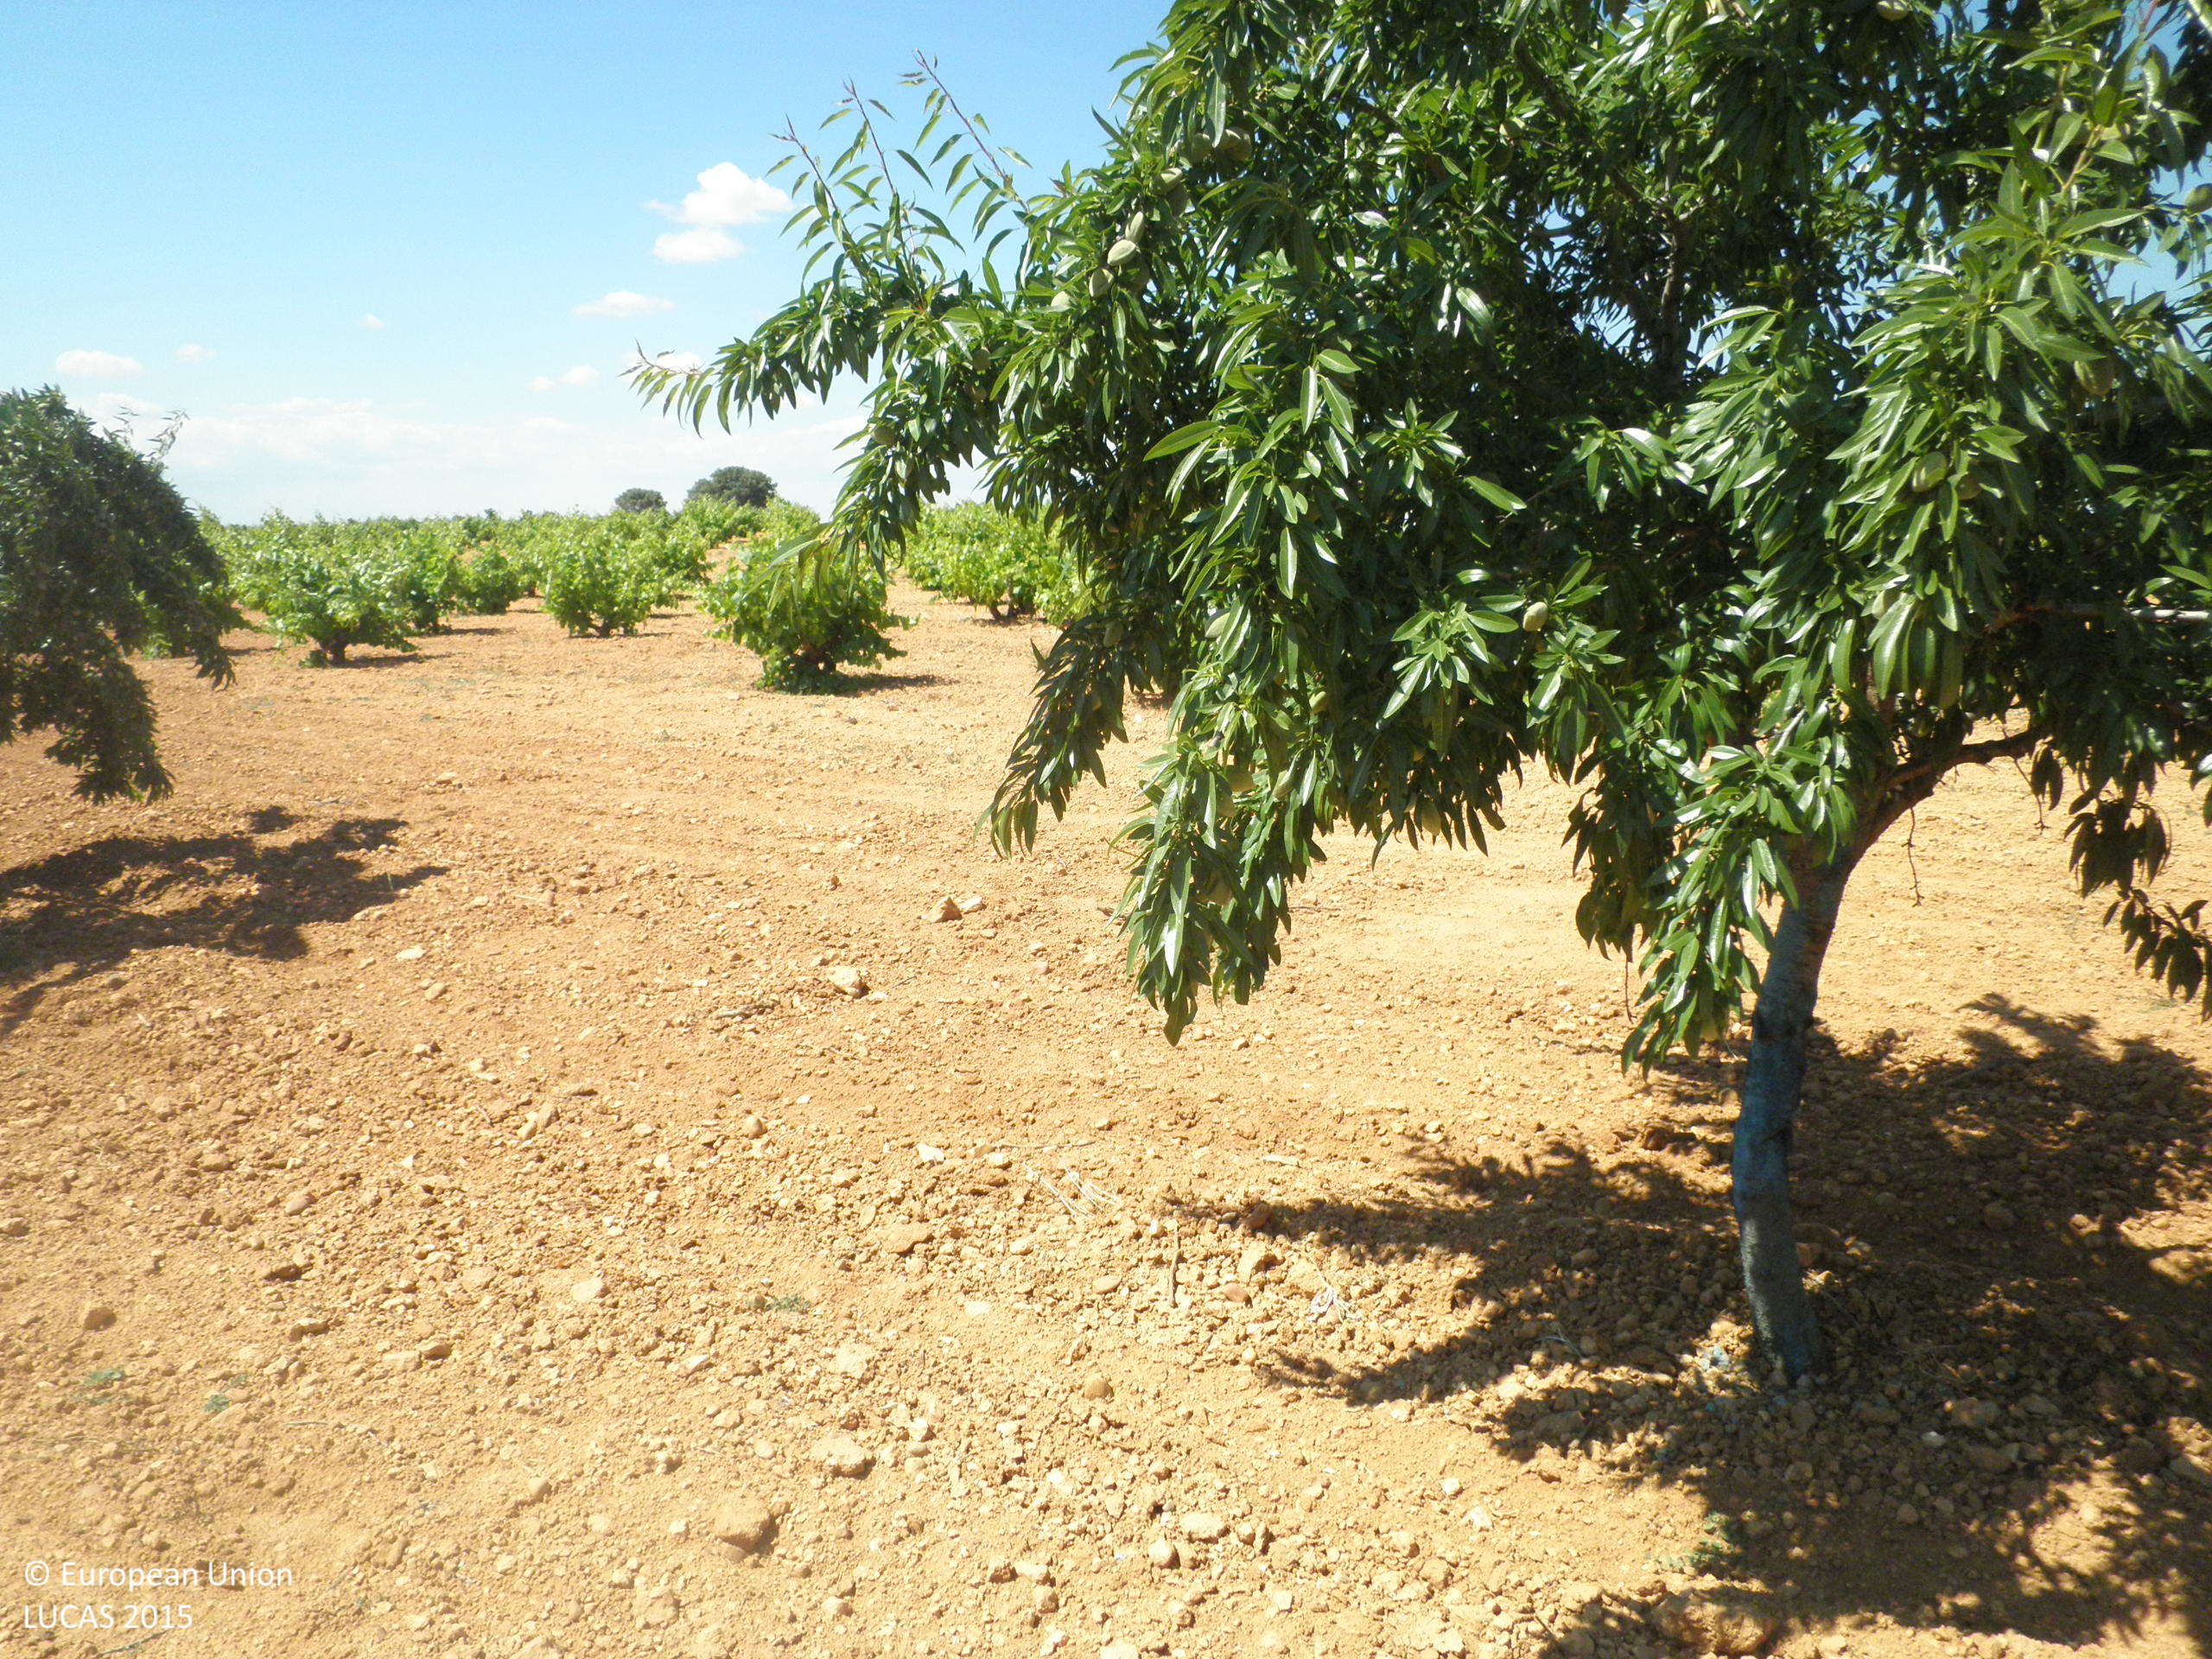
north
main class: Cropland
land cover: Nuts trees
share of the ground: 10 - 25 %
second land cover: Other bare soil
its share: > 75 %
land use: Agriculture (excluding fallow land and kitchen gardens)
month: June
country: ES
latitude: 39.3866
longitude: -1.8124
